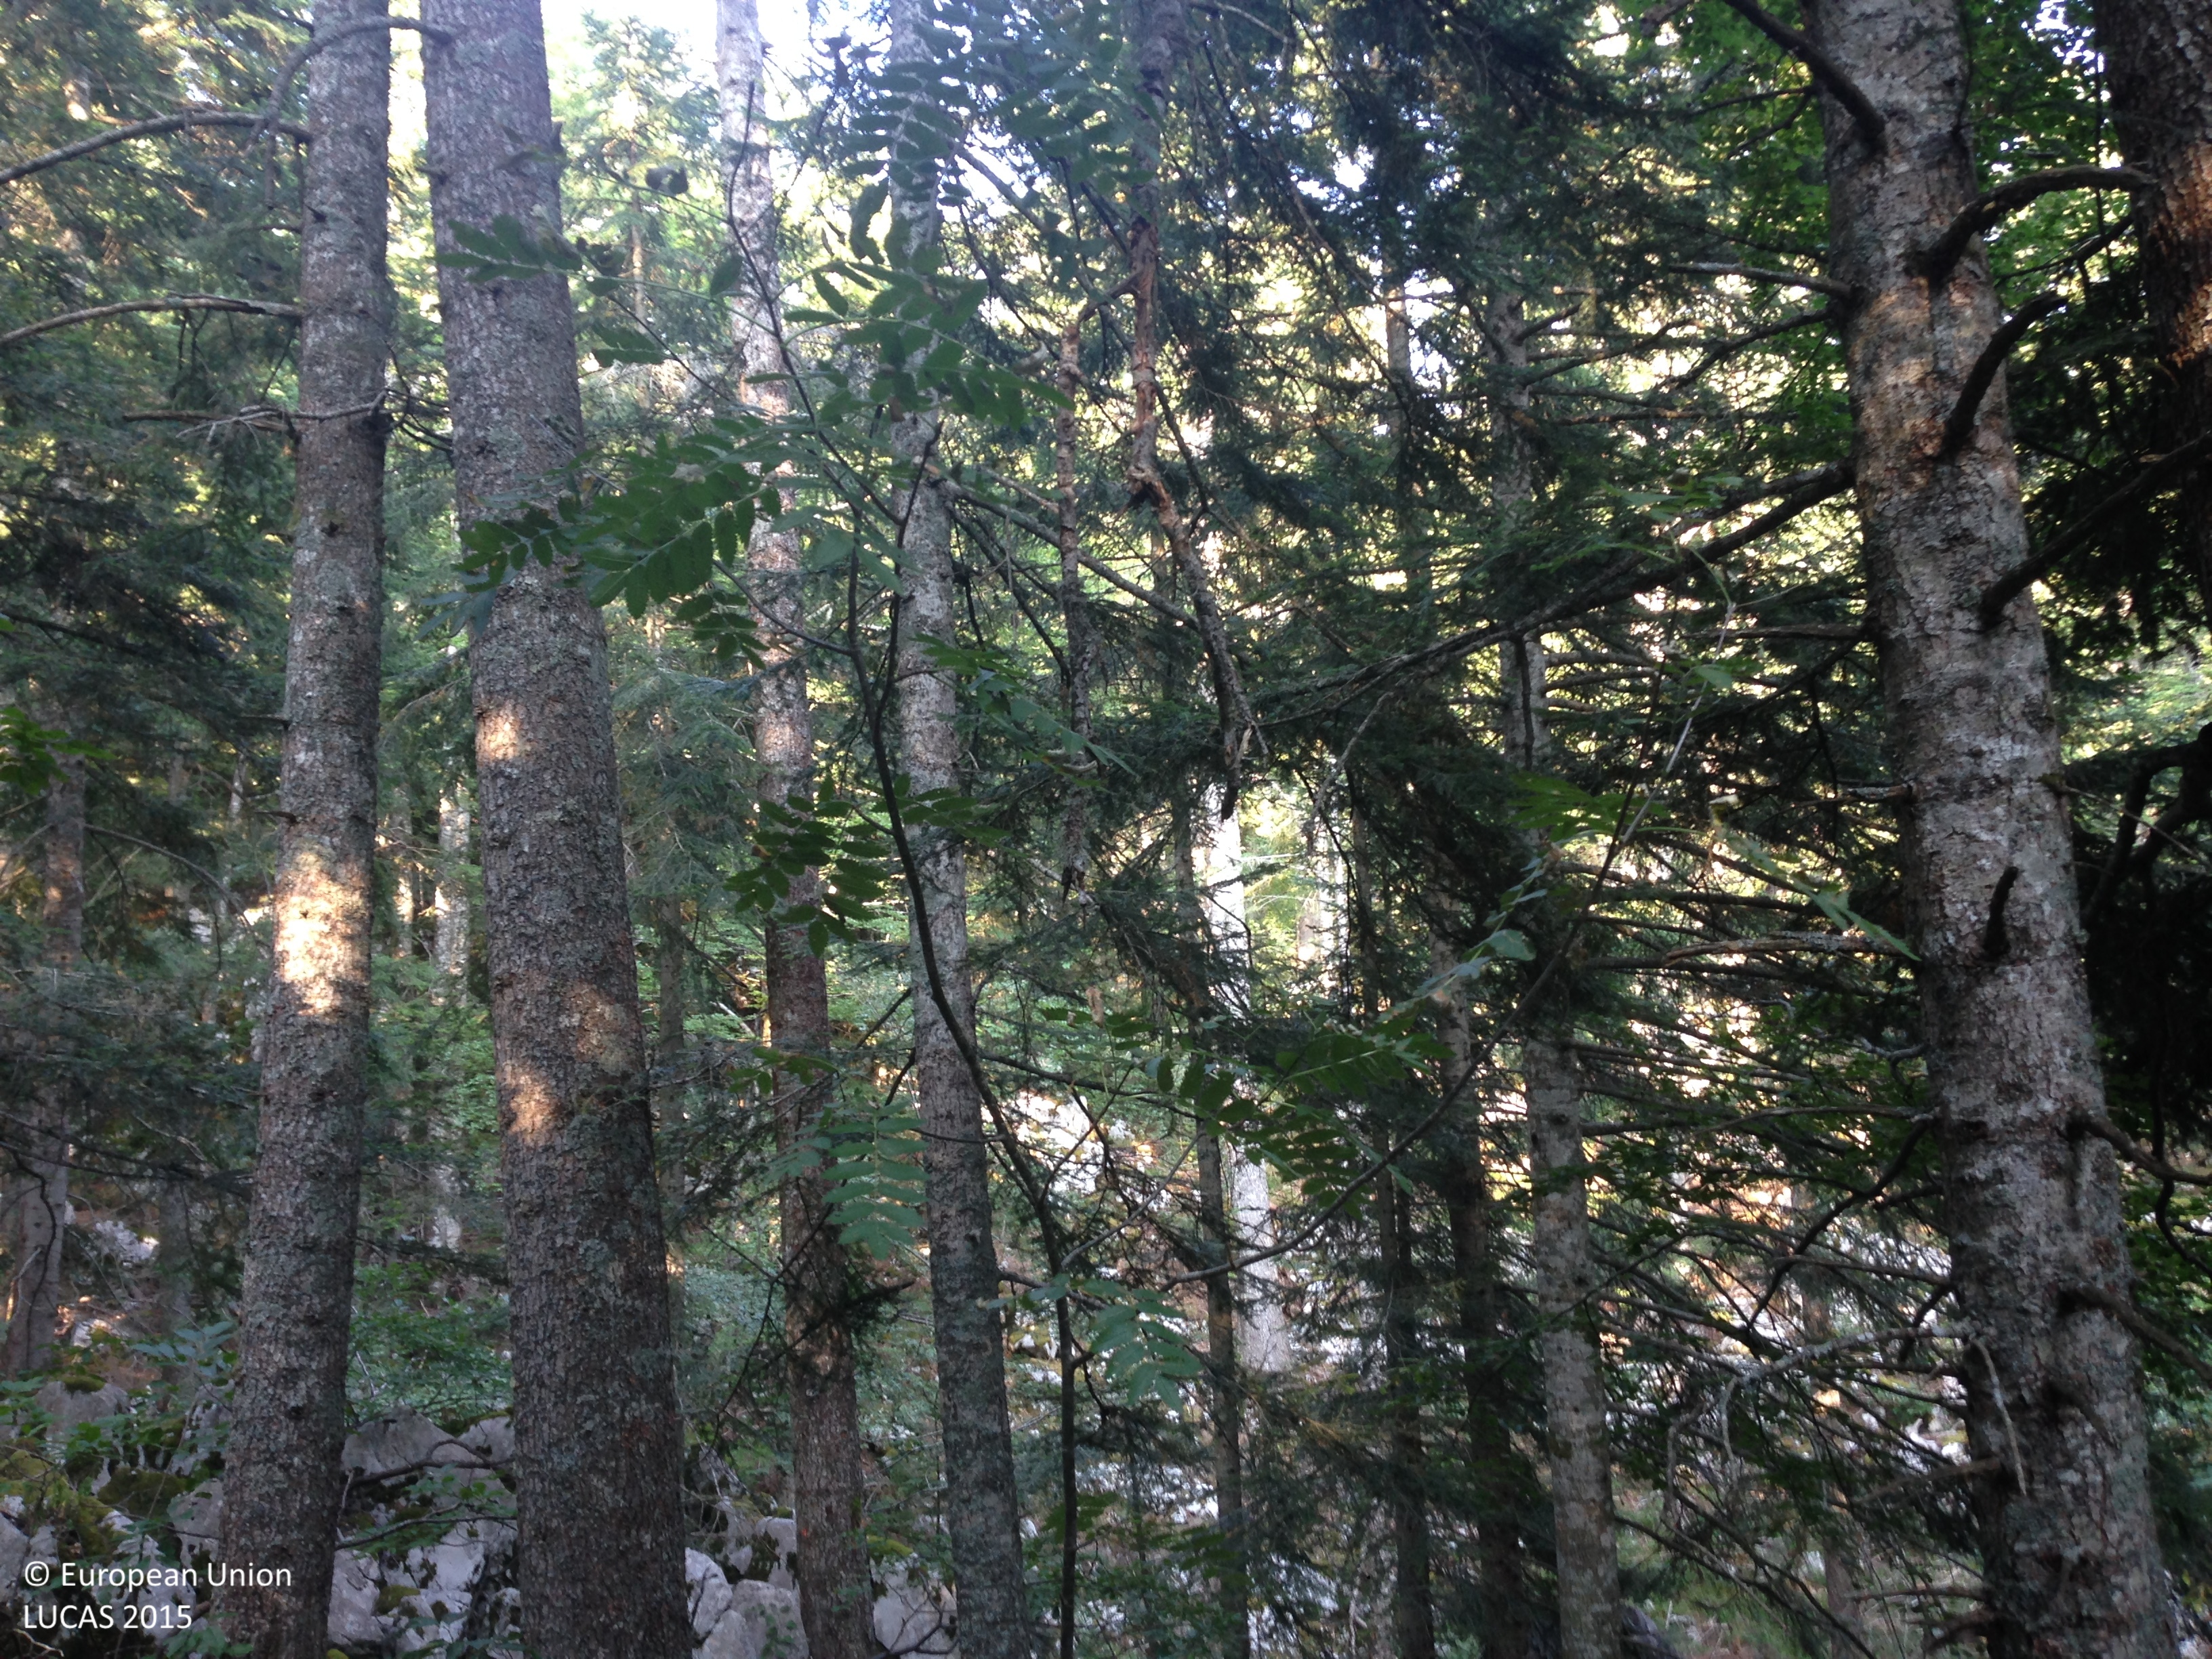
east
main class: Woodland
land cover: Other mixed woodland
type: coniferous forest of the mediterranean region
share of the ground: > 75 %
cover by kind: coniferous forest trees 40 %, broadleaved forest trees 20 %, unconsolidated bare surface 15 %, shrubs 10 %, herbaceous plants 5 %, lichens and mosses 5 %, consolidated bare surface 5 %
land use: Forestry
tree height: > 5 m
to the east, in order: Other mixed woodland; Tracks; Other mixed woodland
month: July
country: HR
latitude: 44.8614
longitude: 15.0182
